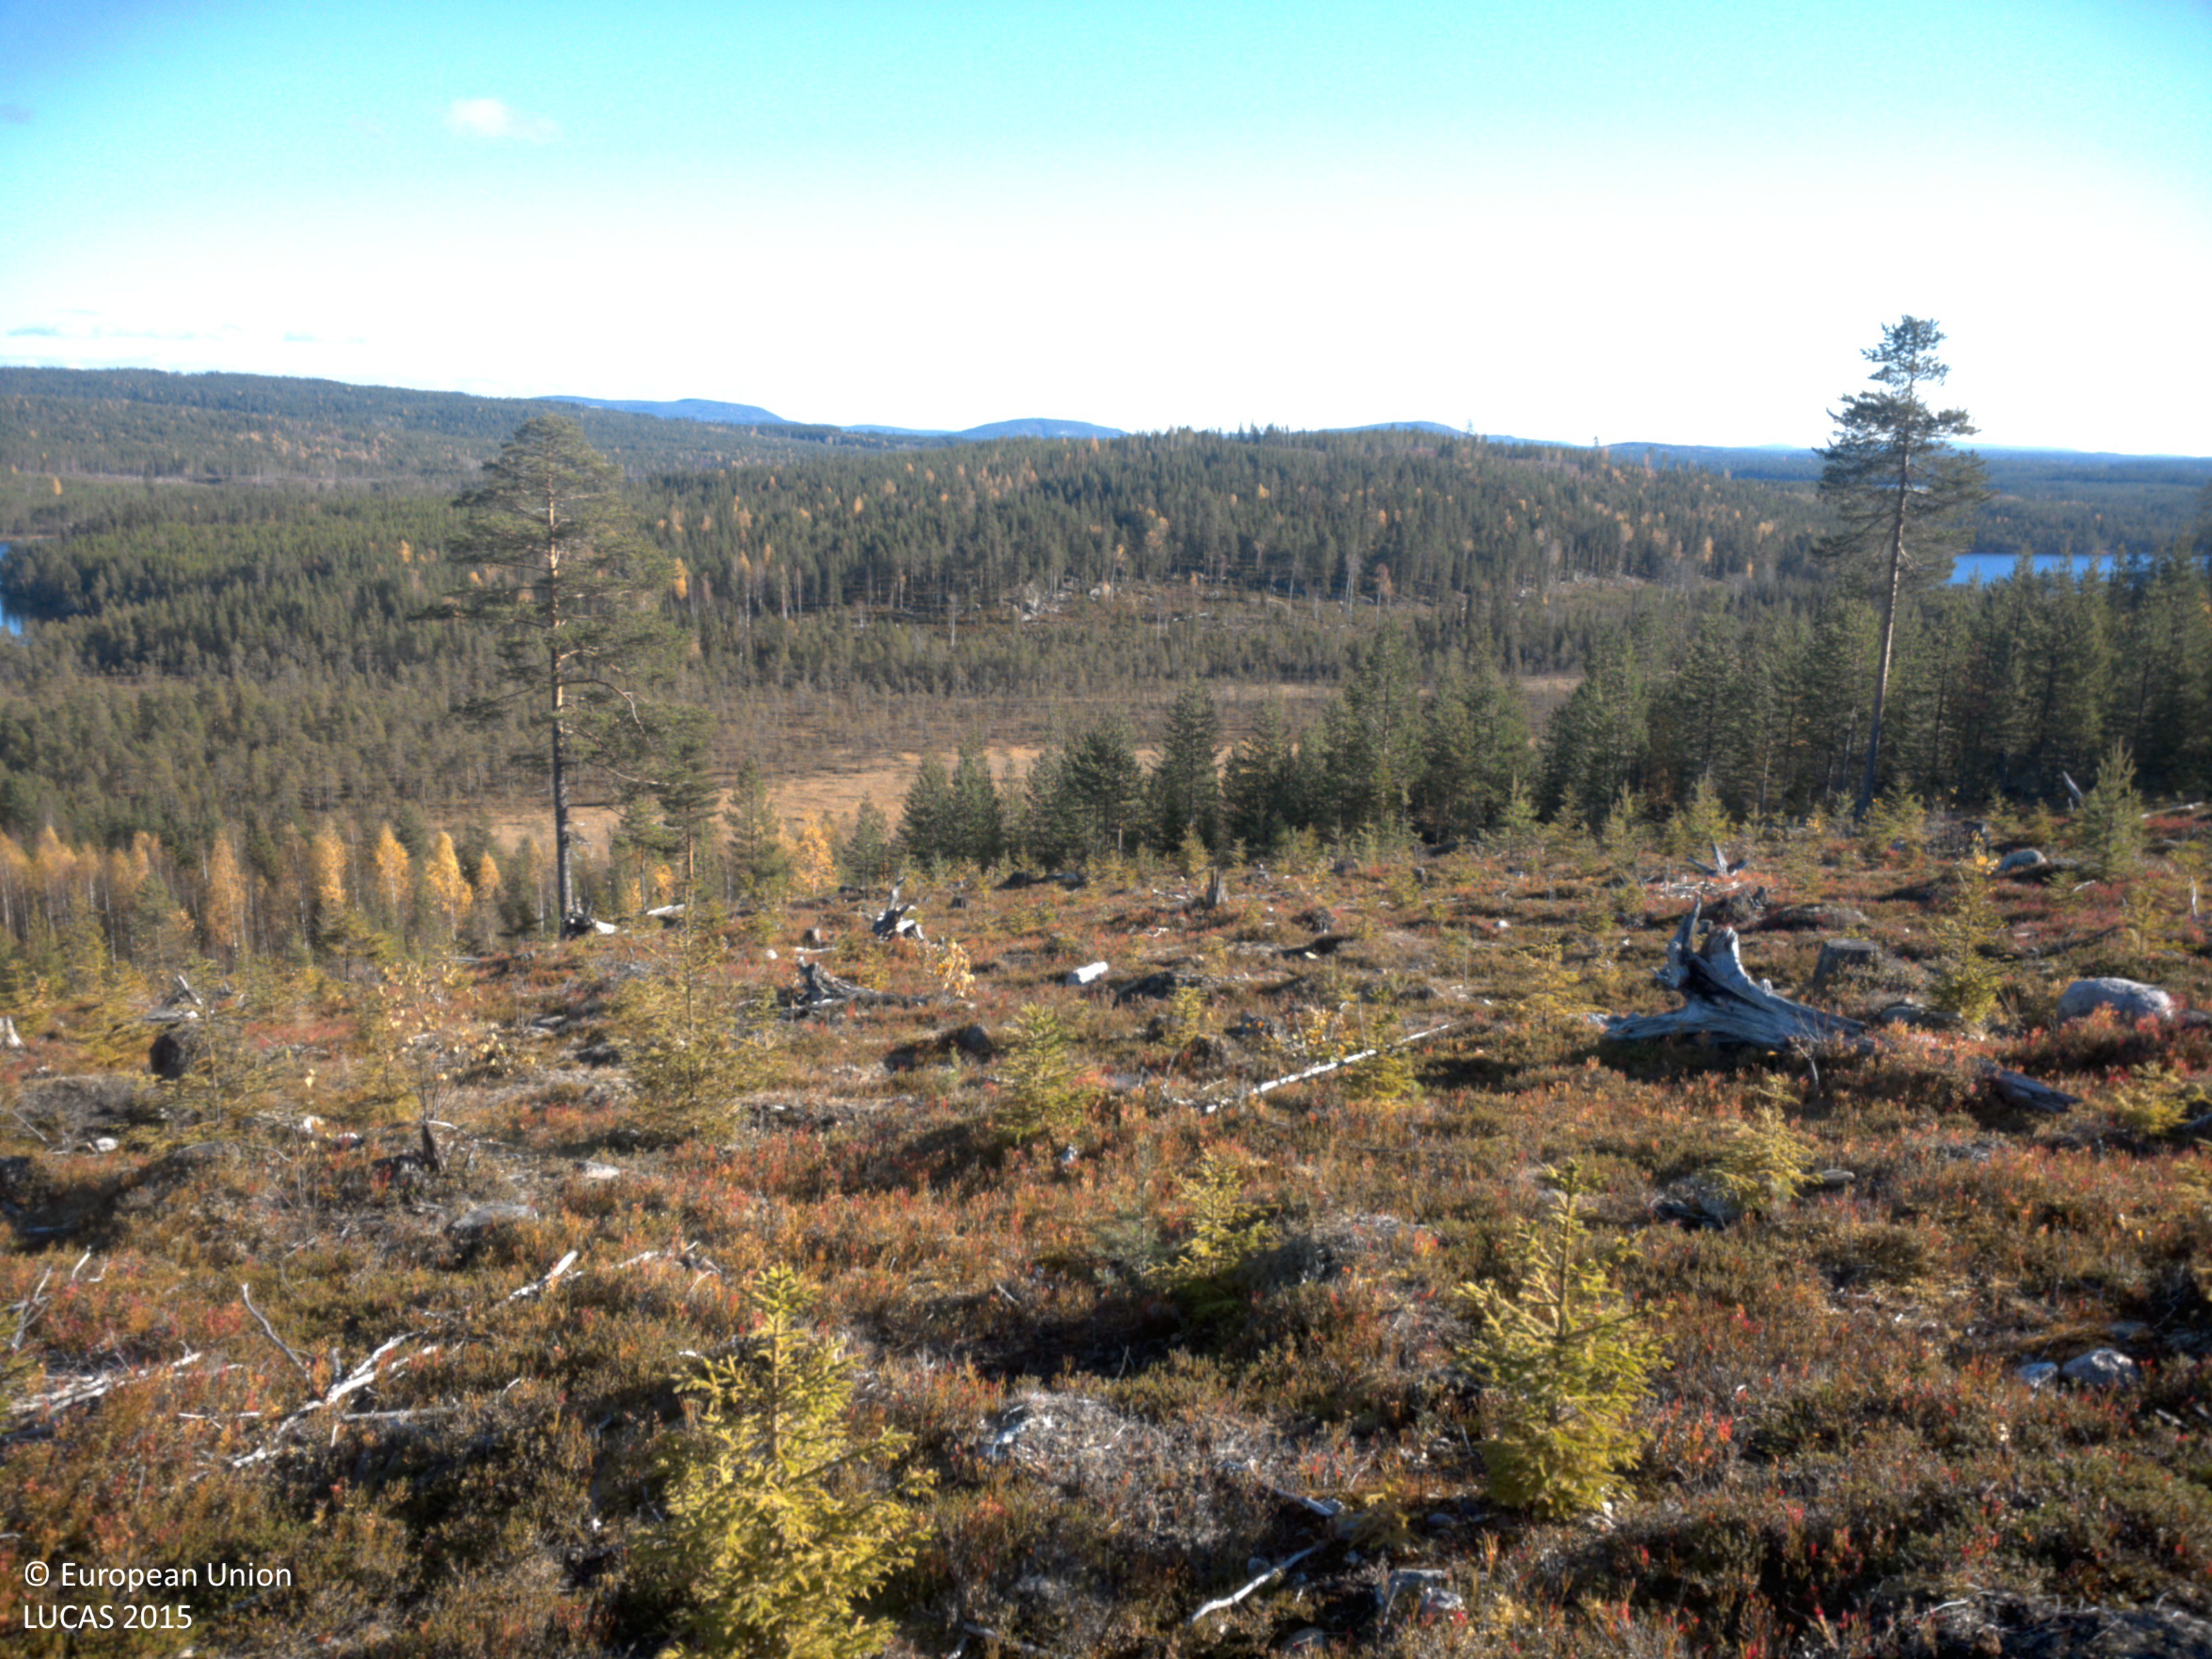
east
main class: Shrubland
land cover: Shrubland with sparse tree cover
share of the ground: > 75 %
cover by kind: shrubs 80 %, lichens and mosses 10 %, coniferous forest trees 5 %, herbaceous plants 5 %
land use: Forestry
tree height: < 5 m
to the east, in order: Shrubland with sparse tree cover; Pine dominated coniferous woodland; Pine dominated mixed woodland; Ditches and canals; Grass margins; Paved roads, cycling and walking lanes; Grass margins; Pine dominated mixed woodland; Peatbogs
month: October
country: SE
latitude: 64.7689
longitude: 18.5235
